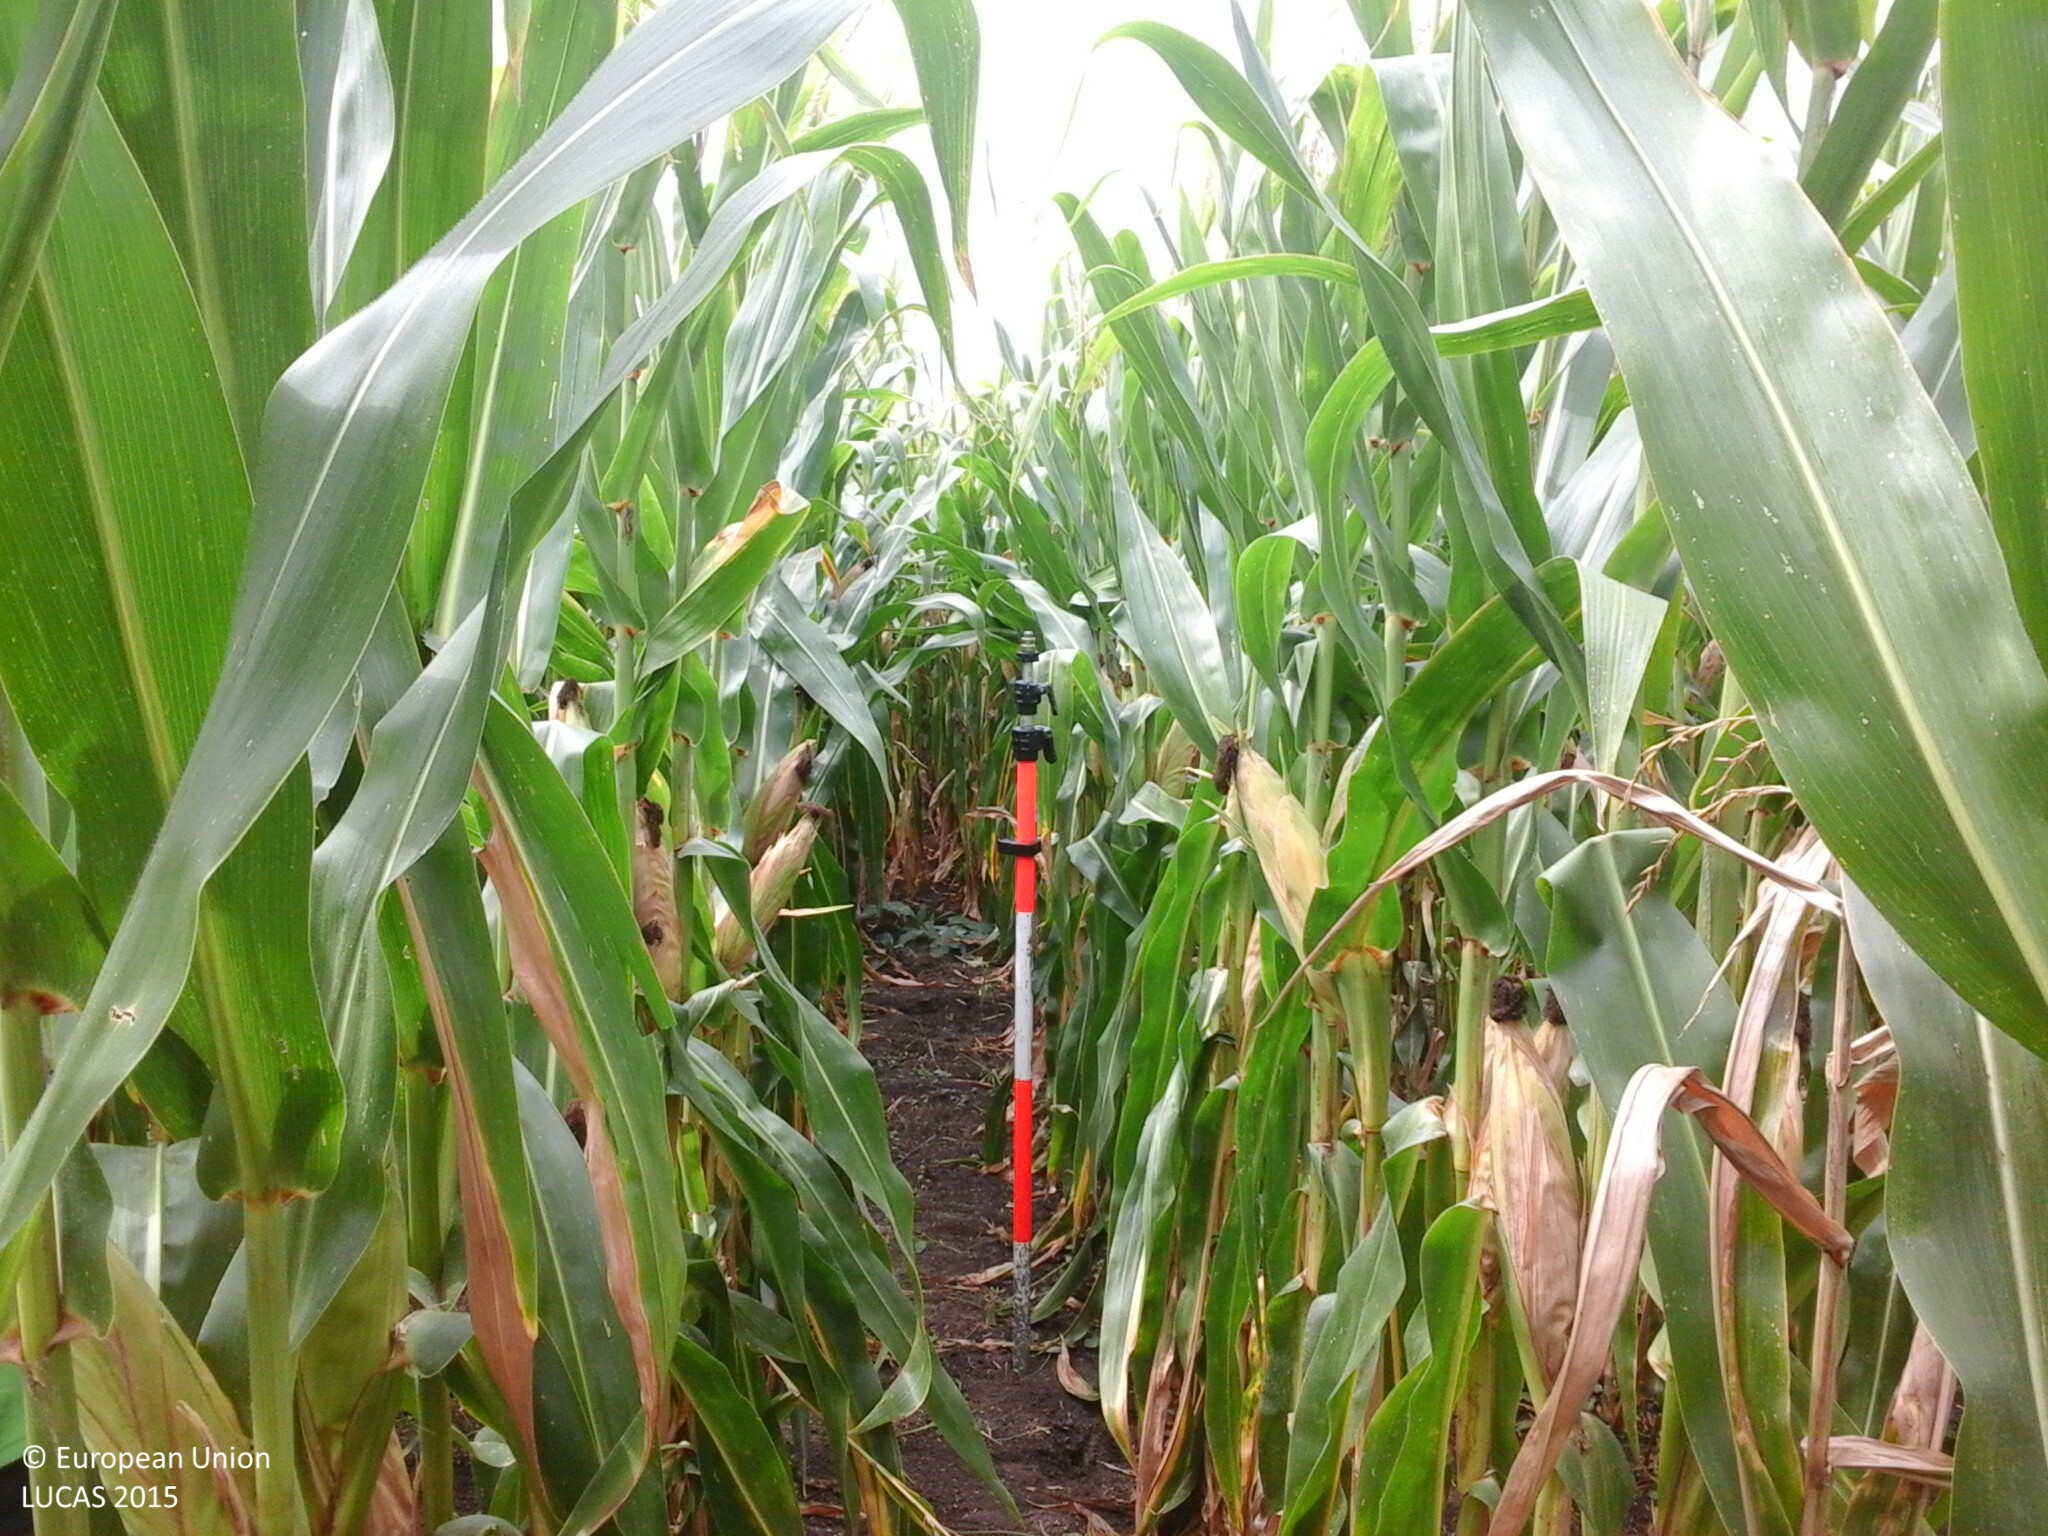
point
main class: Cropland
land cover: Maize
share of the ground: > 75 %
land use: Agriculture (excluding fallow land and kitchen gardens)
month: August
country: HU
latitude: 47.0263
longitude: 21.6074
